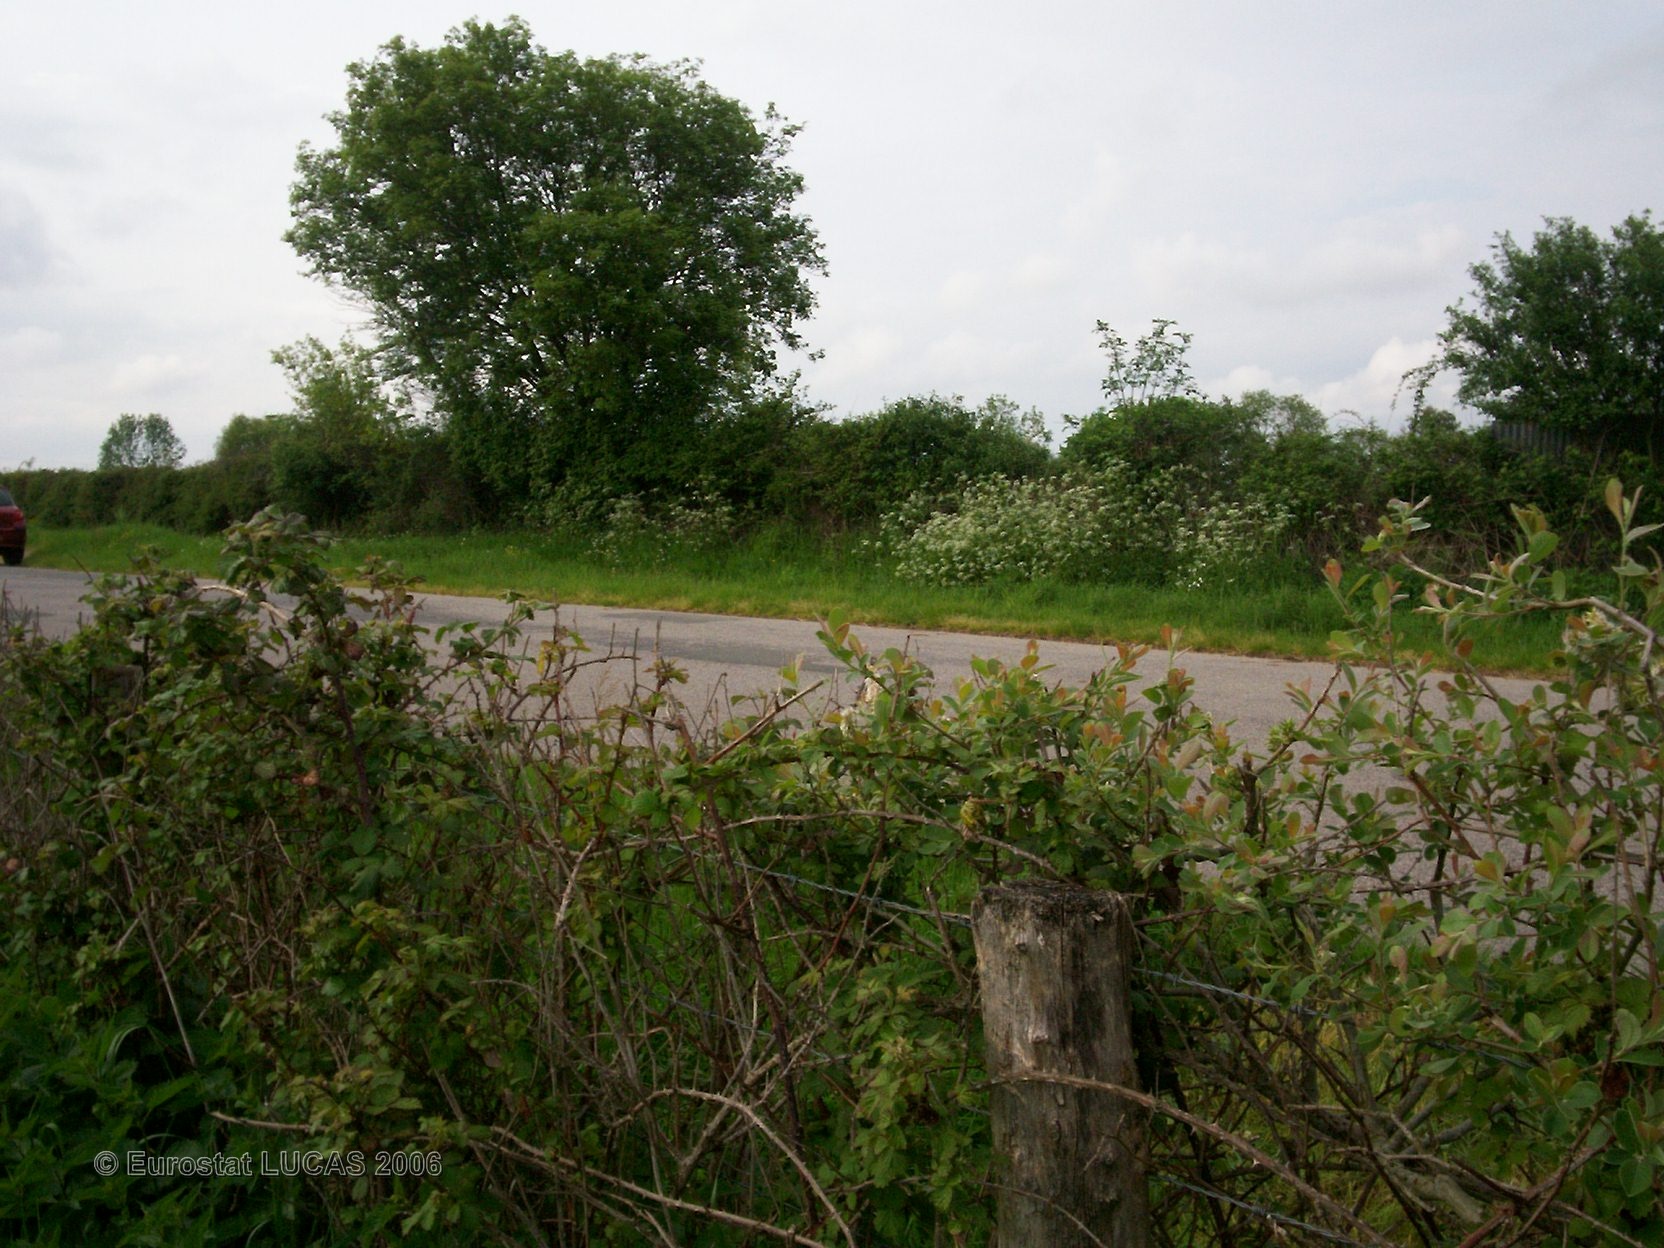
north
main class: Grassland
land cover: Grassland without tree/shrub cover
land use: Agriculture (excluding fallow land and kitchen gardens)
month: April
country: FR
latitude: 46.6835
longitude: -0.3414
